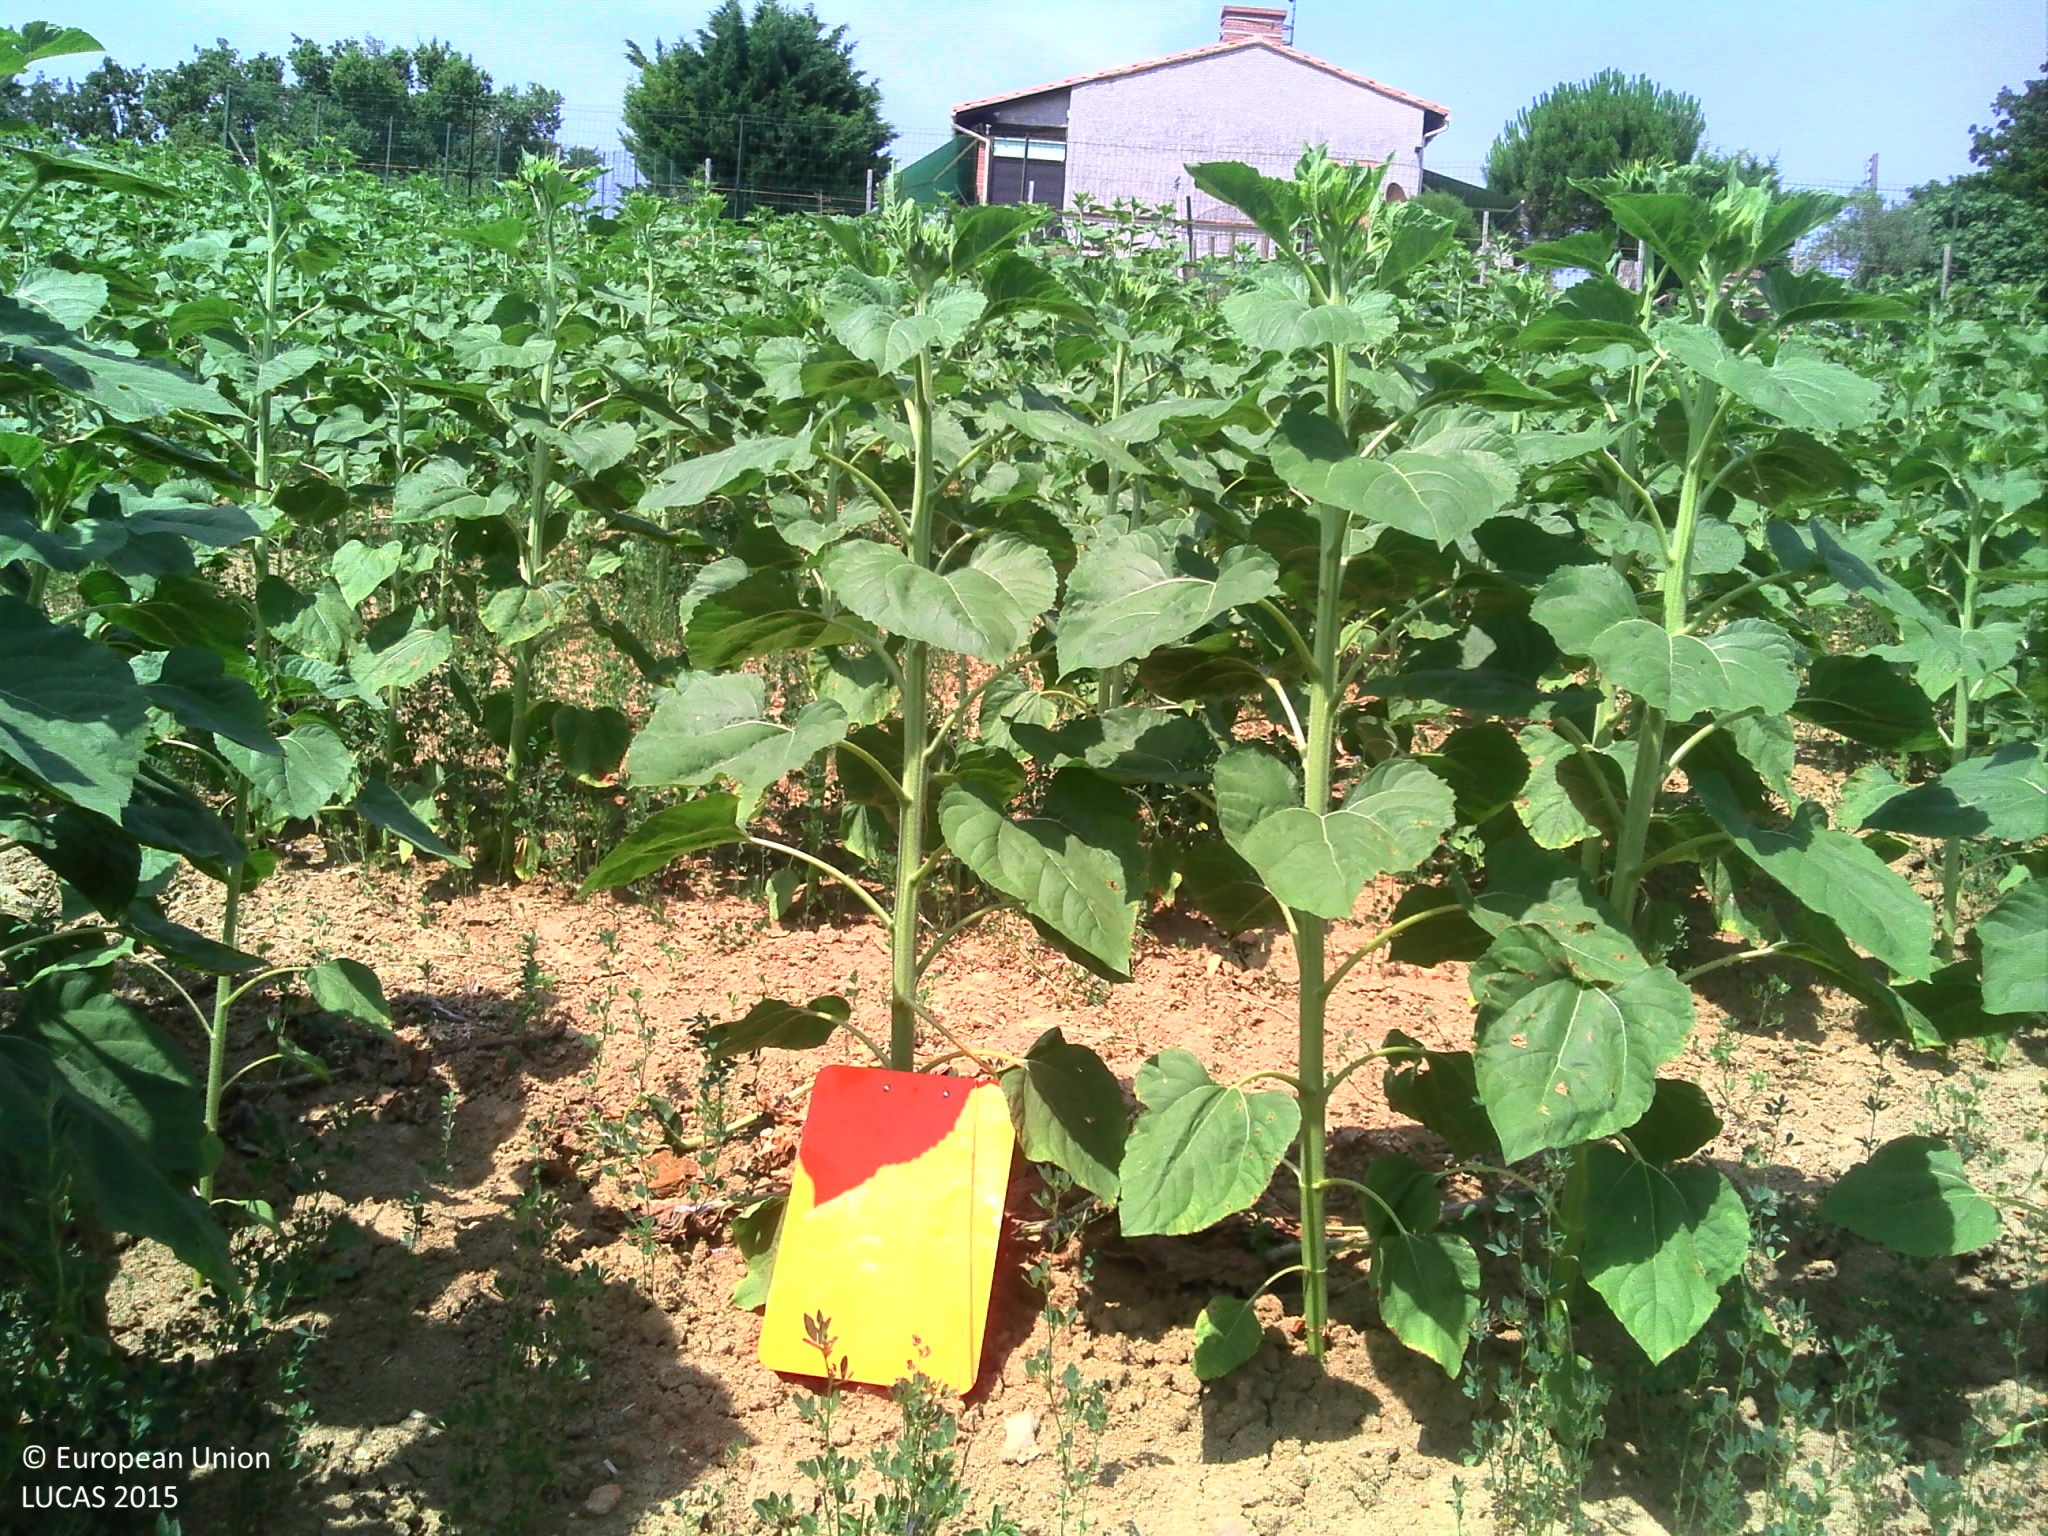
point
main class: Cropland
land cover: Sunflower
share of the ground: > 75 %
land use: Agriculture (excluding fallow land and kitchen gardens)
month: July
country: FR
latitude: 43.6856
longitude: 1.6292
